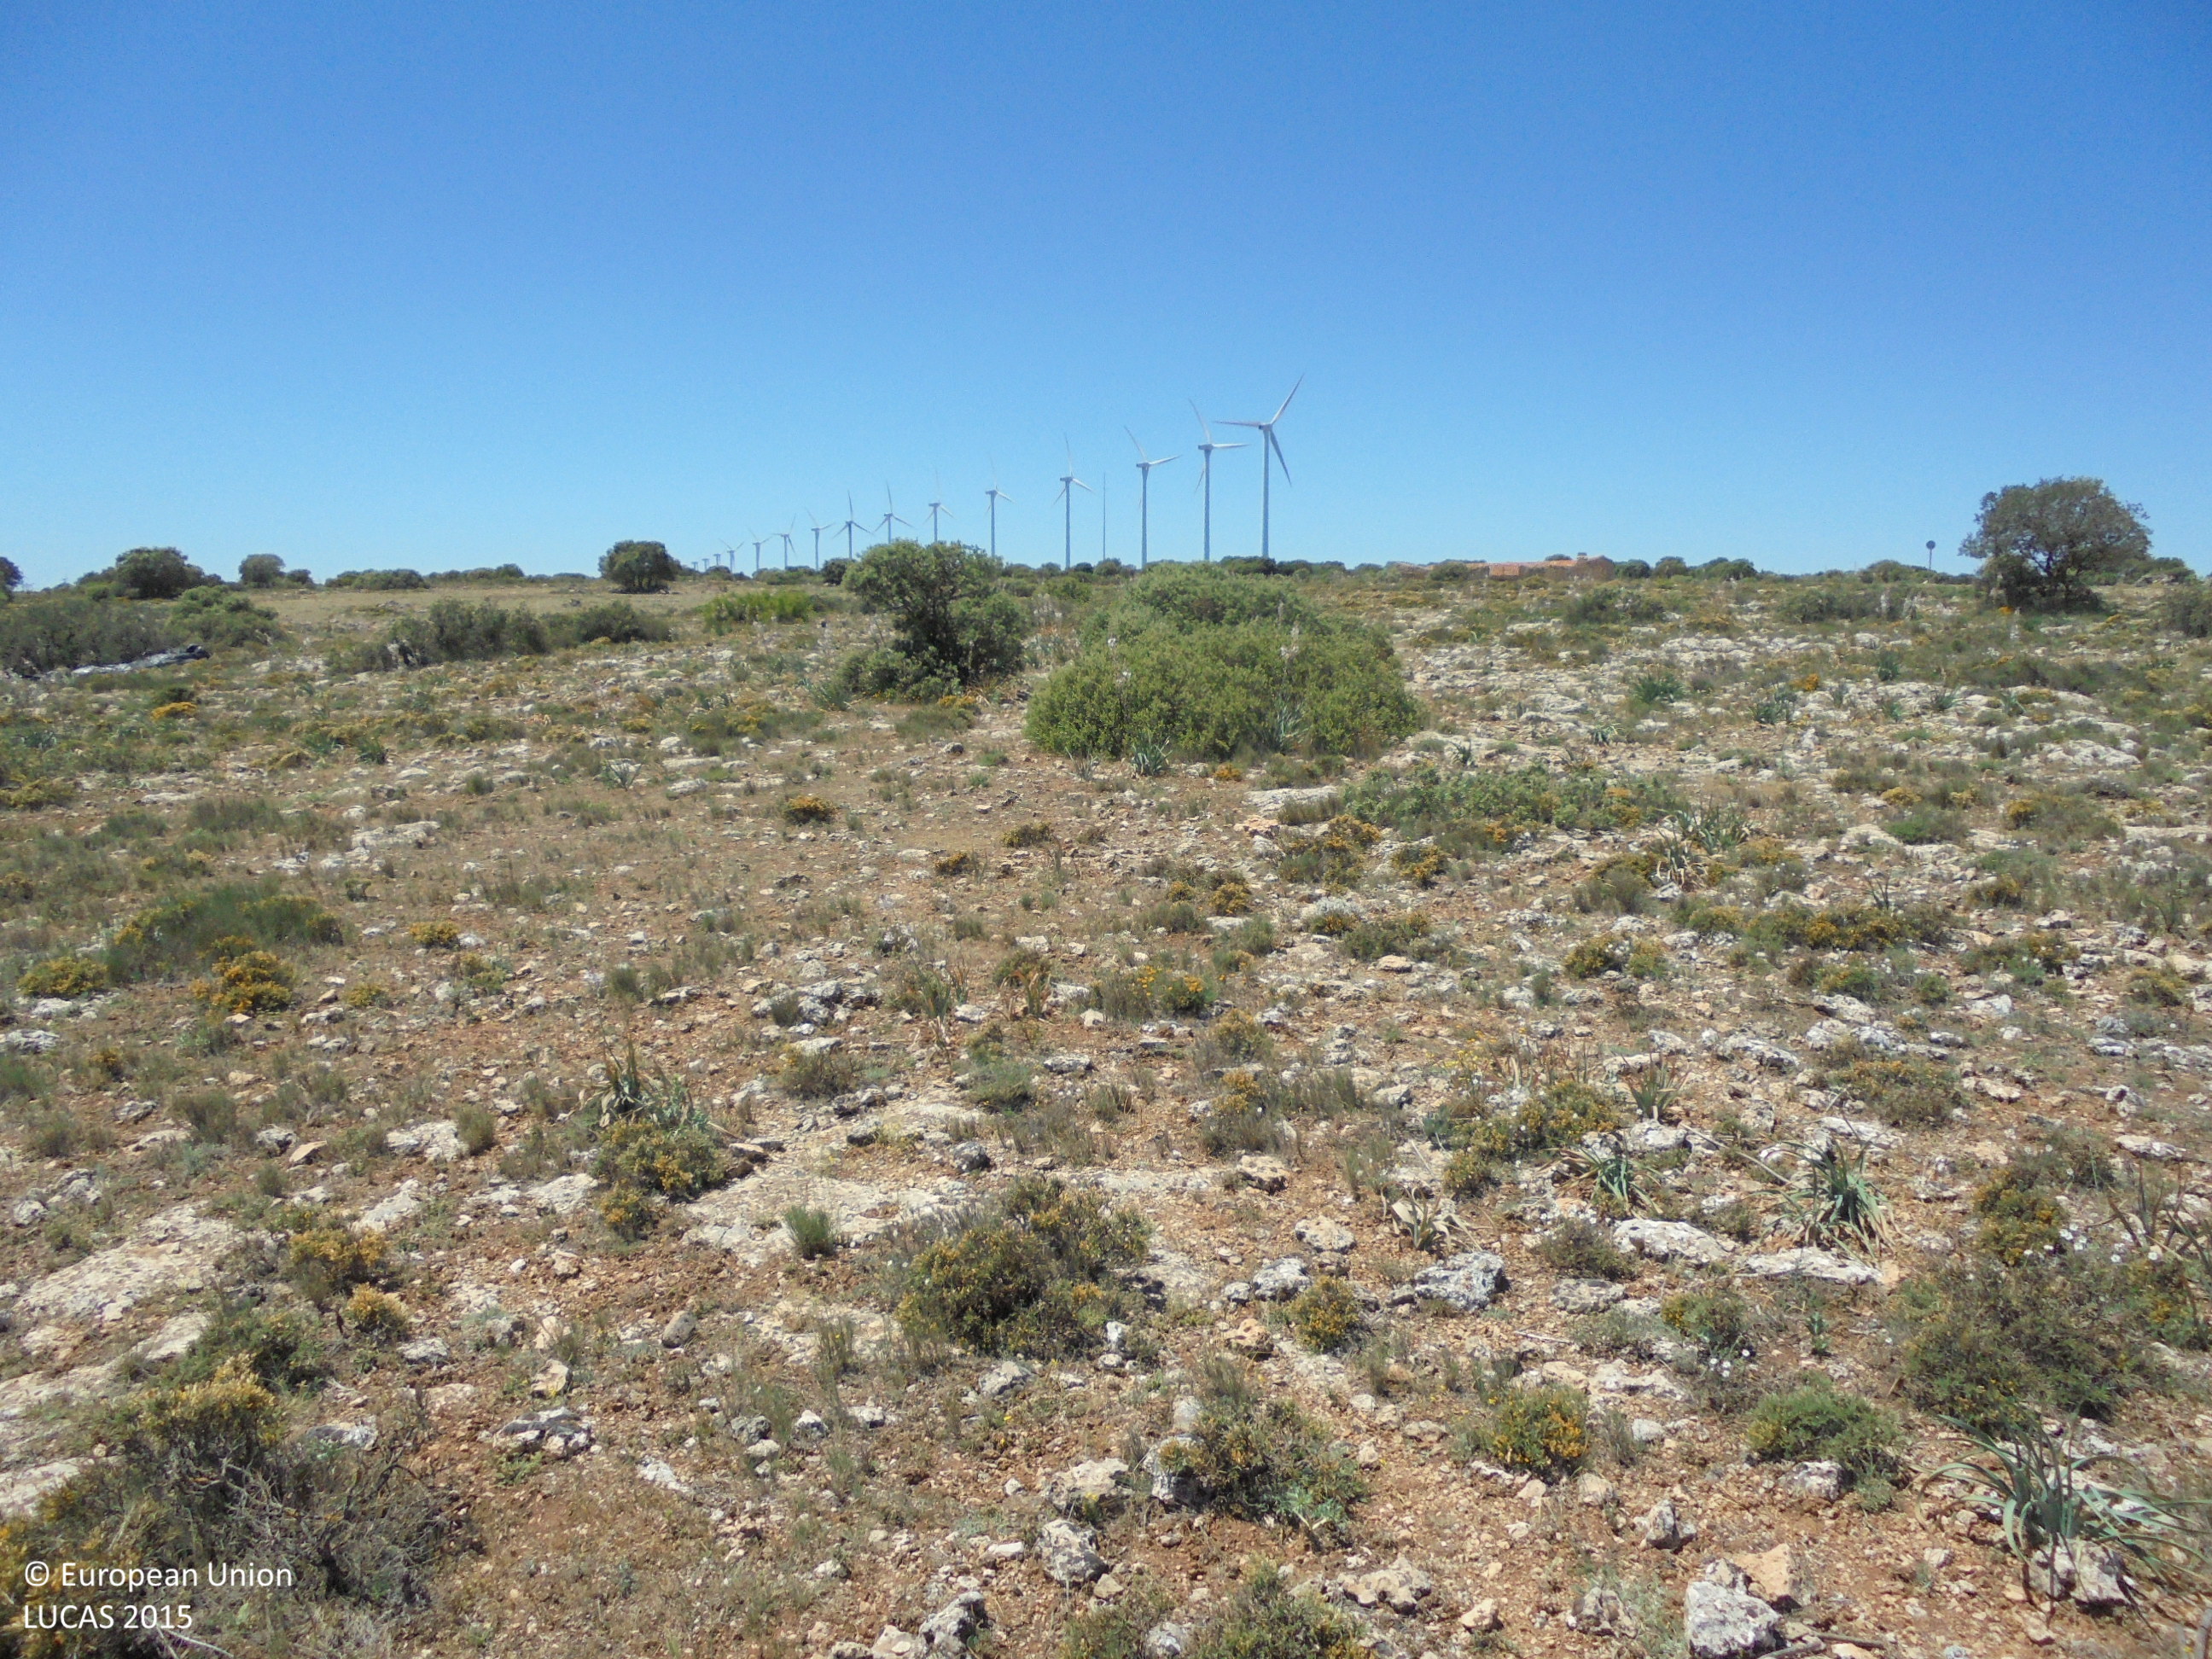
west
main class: Shrubland
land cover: Shrubland without tree cover
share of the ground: 50 - 75 %
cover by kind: shrubs 70 %, consolidated bare surface 20 %, unconsolidated bare surface 10 %
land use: Agriculture (excluding fallow land and kitchen gardens)
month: May
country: ES
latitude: 38.9905
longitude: -1.4621
